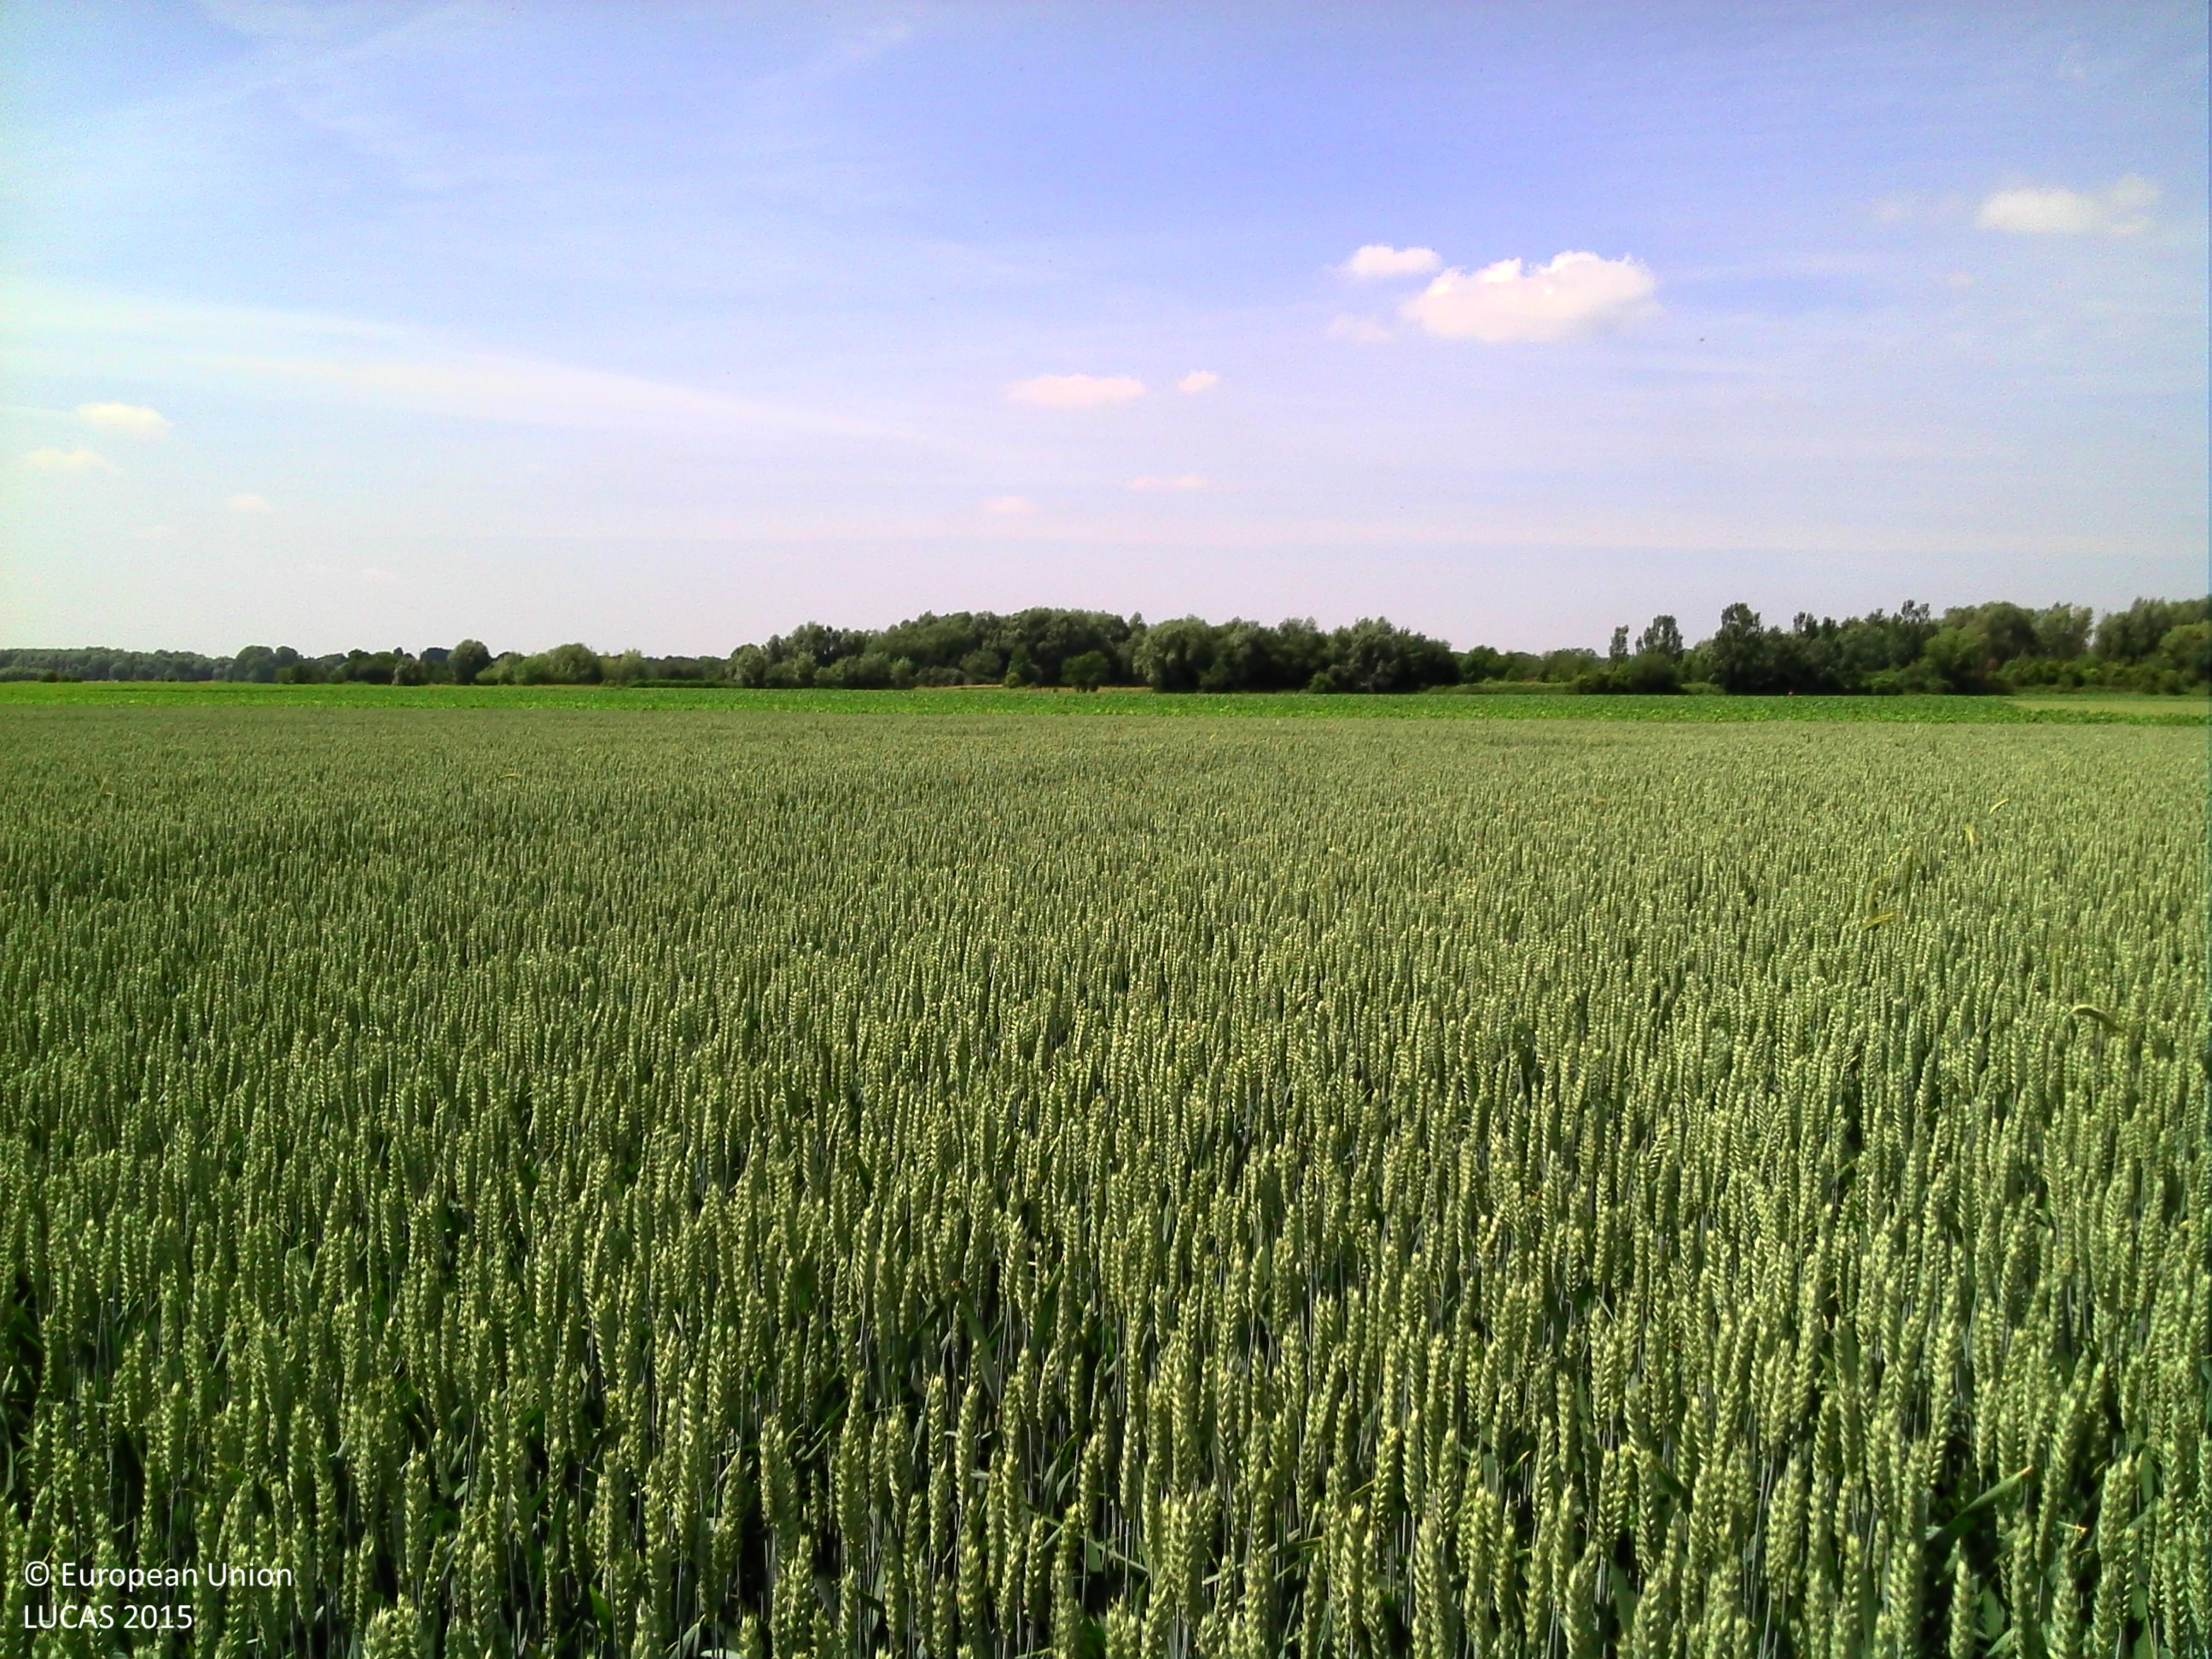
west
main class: Cropland
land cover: Common wheat
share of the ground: > 75 %
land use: Agriculture (excluding fallow land and kitchen gardens)
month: June
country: BE
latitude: 50.9141
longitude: 5.7173
